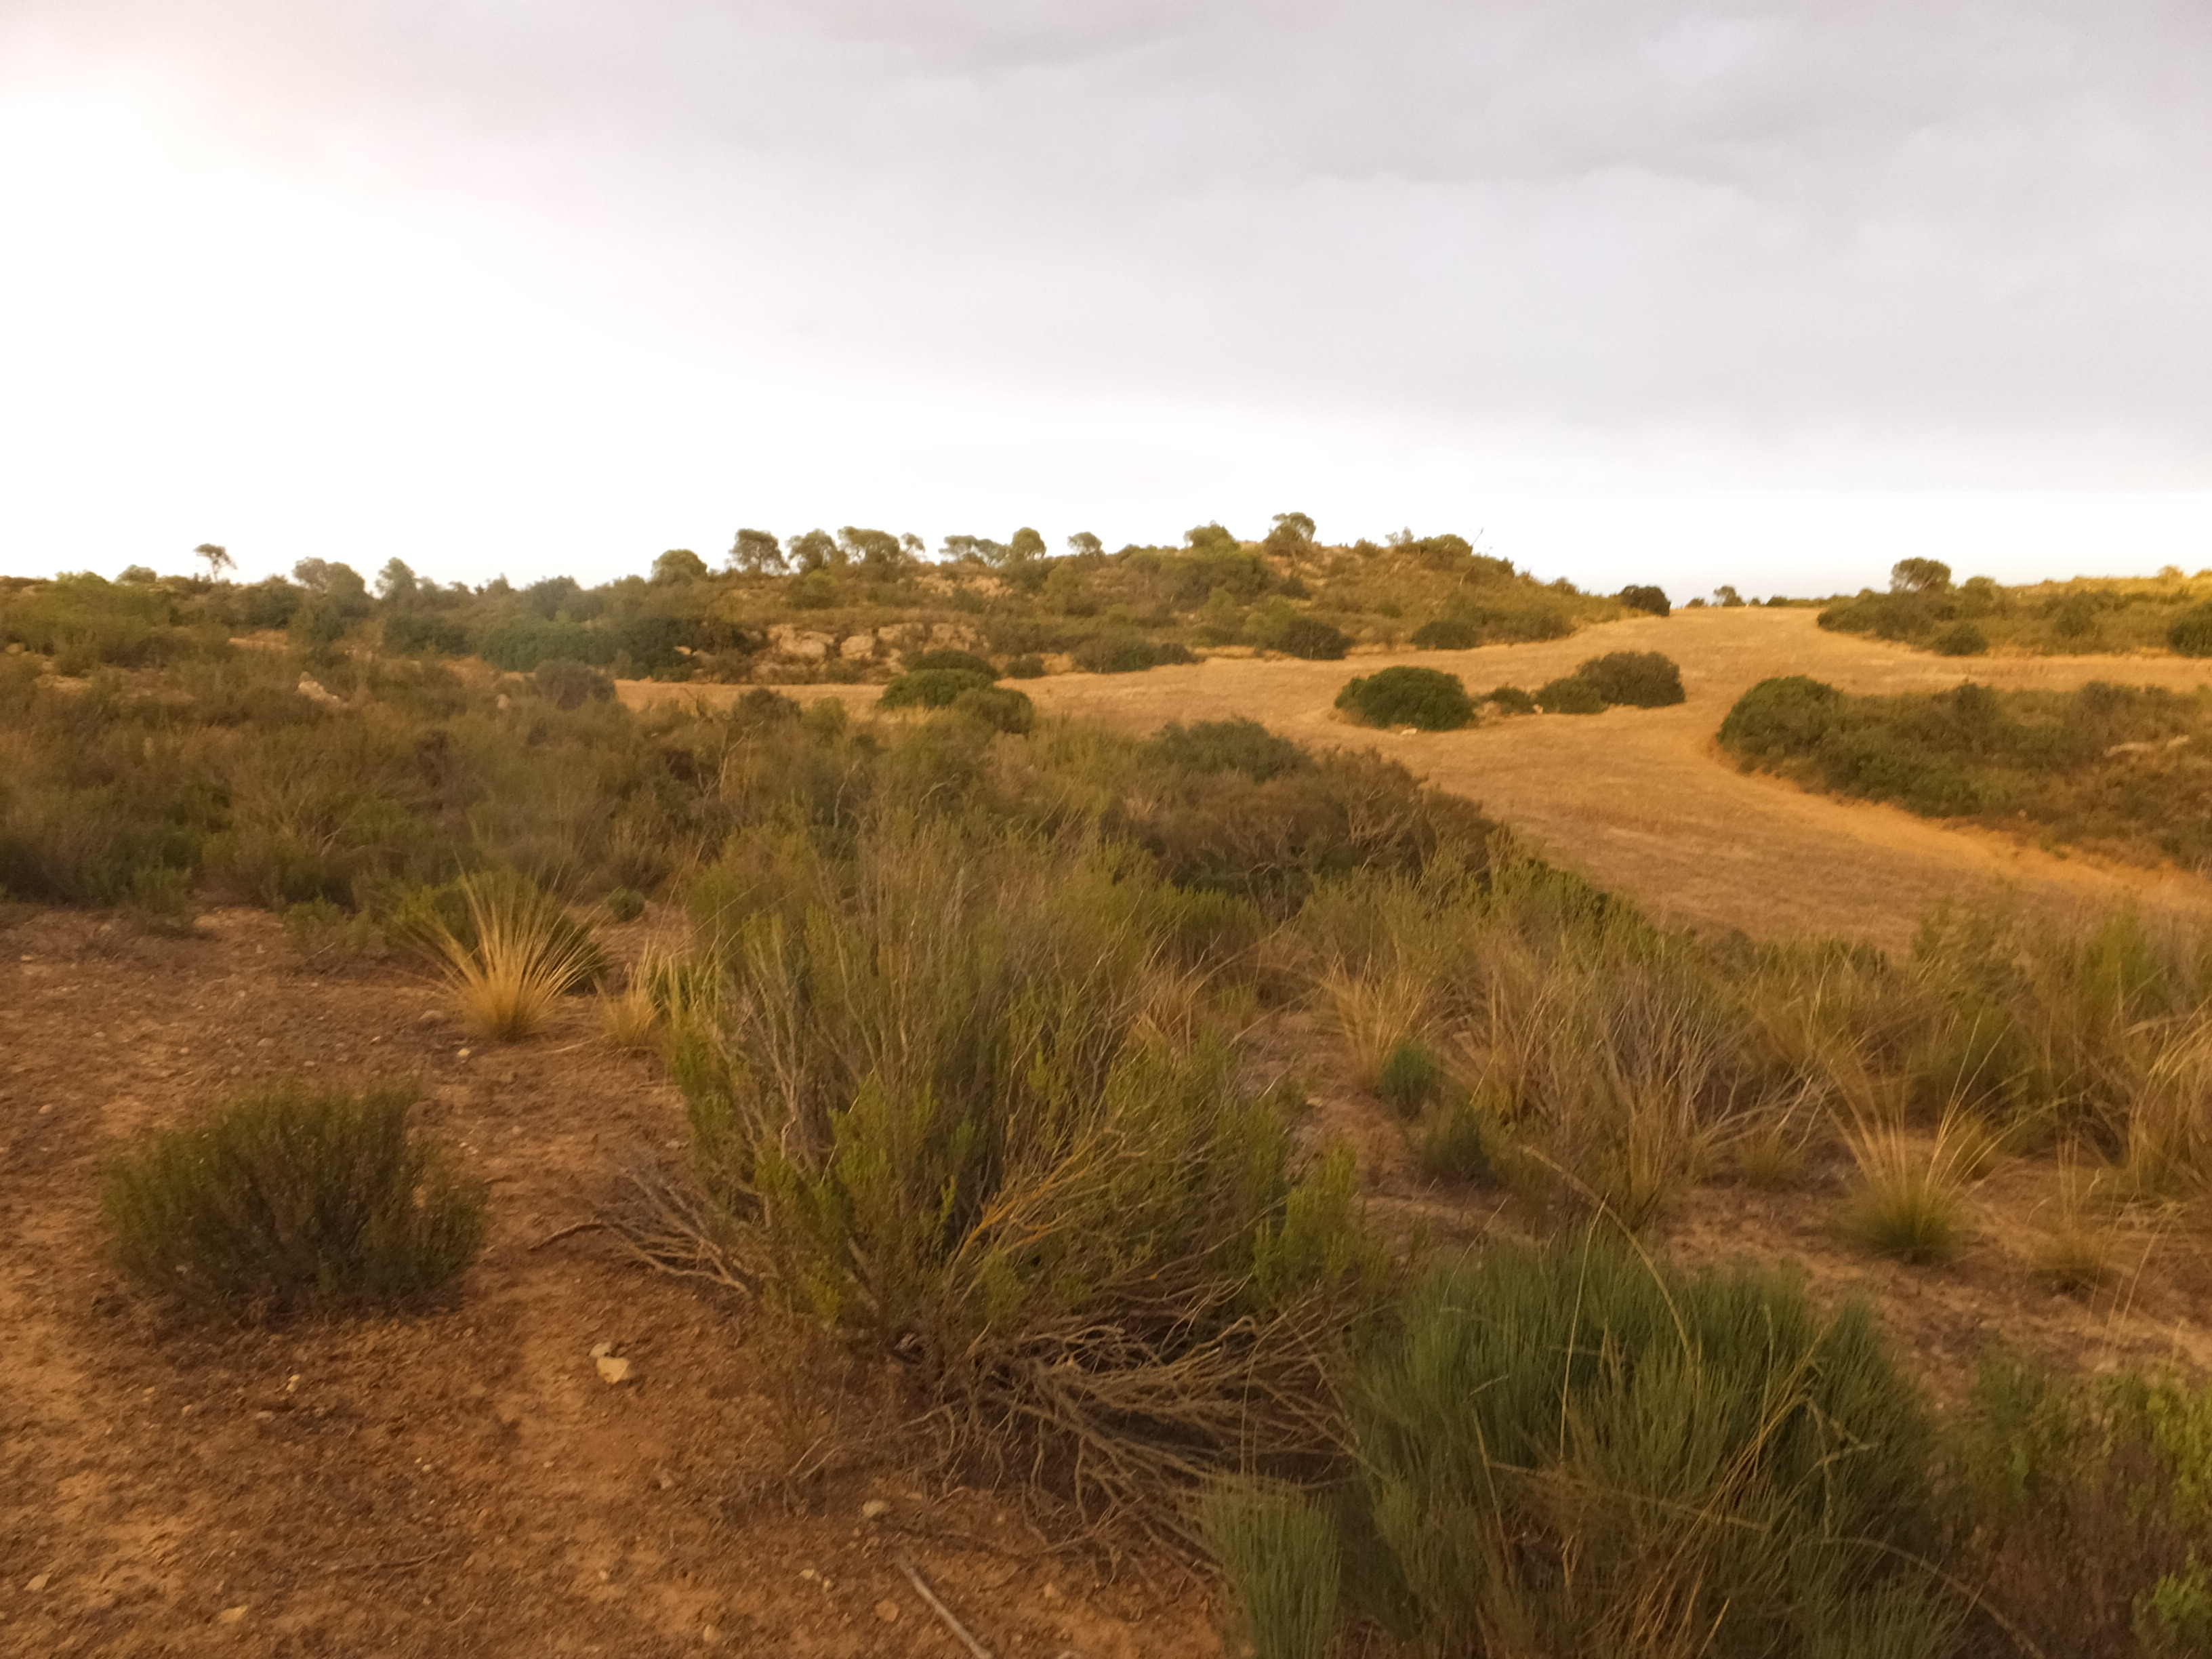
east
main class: Shrubland
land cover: Shrubland with sparse tree cover
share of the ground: > 75 %
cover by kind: shrubs 70 %, herbaceous plants 20 %, coniferous forest trees 5 %, consolidated bare surface 5 %
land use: Semi-natural and natural areas not in use
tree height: < 5 m
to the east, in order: Shrubland with sparse tree cover; Other bare soil; Shrubland without tree cover; Rock outcrops; Shrubland with sparse tree cover
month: August
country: ES
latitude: 41.3473
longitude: 0.0794
